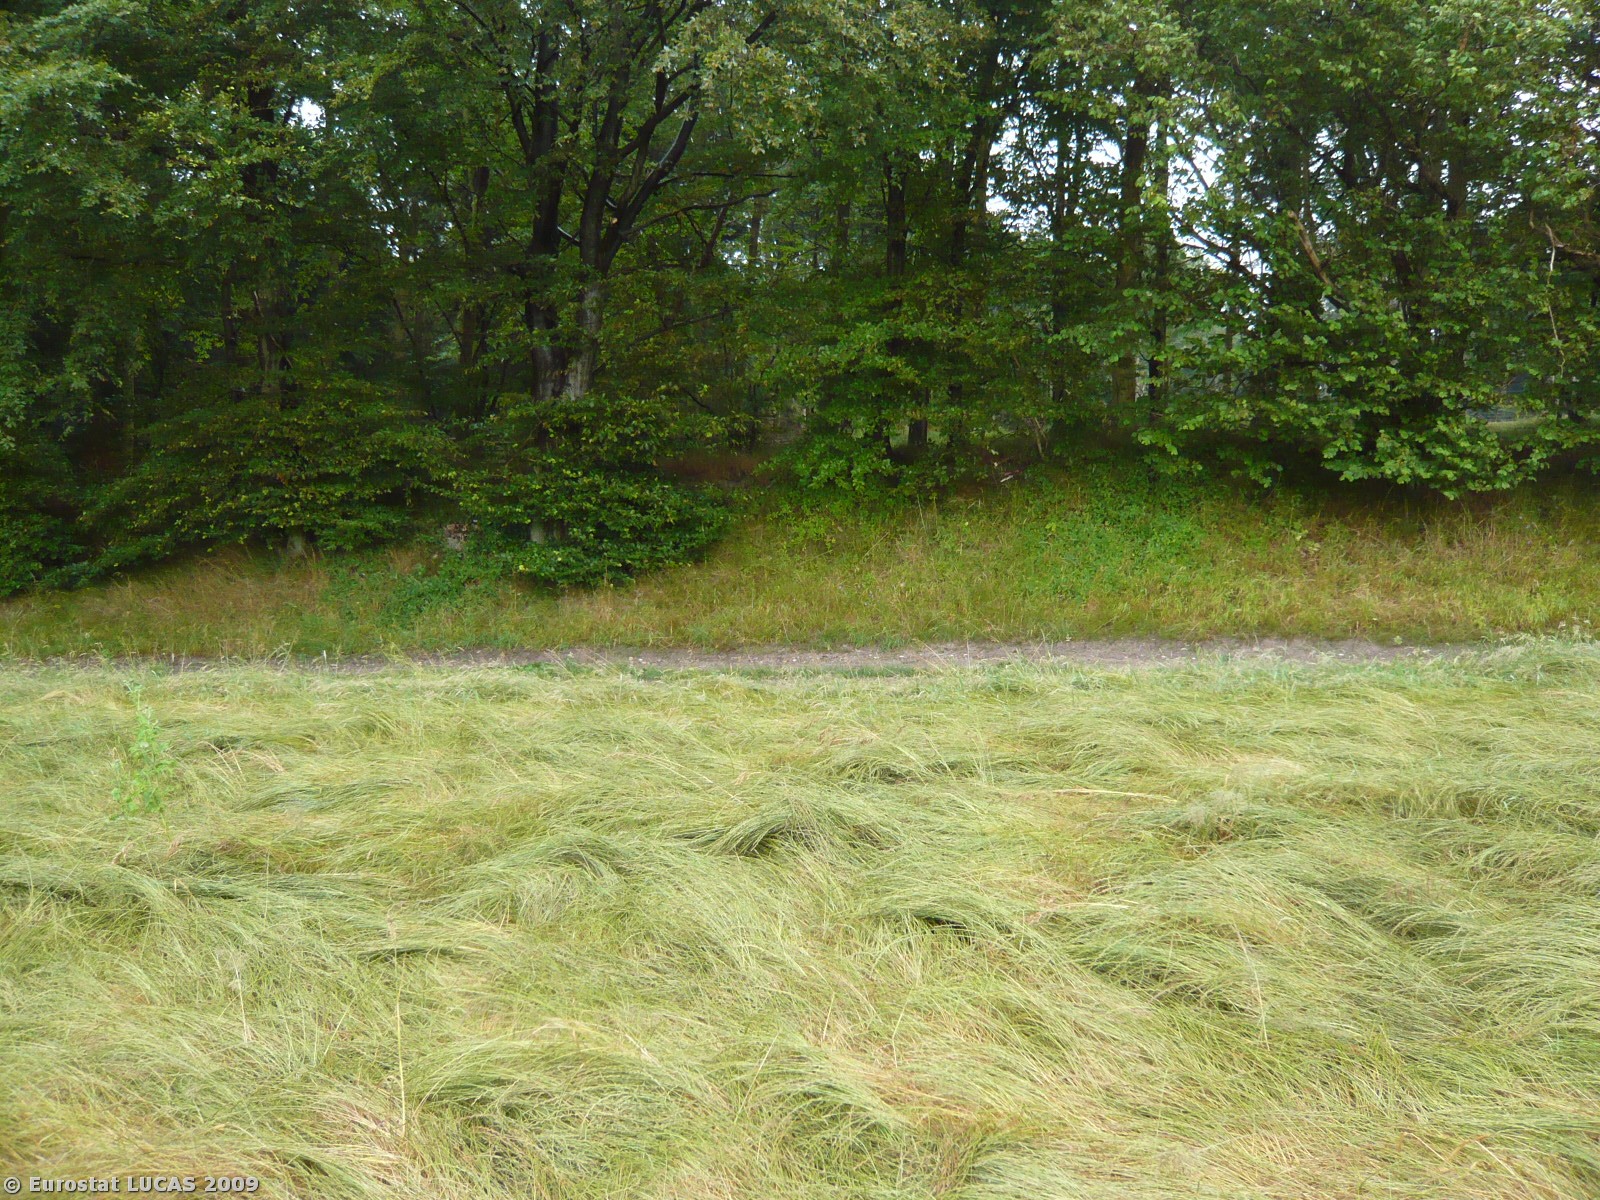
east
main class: Cropland
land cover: Temporary grasslands
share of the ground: > 75 %
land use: Agriculture (excluding fallow land and kitchen gardens)
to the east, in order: Temporary grasslands; Tracks; Broadleaved woodland; Paved roads, cycling and walking lanes; Grass margins; Temporary grasslands
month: July
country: DK
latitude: 55.6709
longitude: 11.8586
